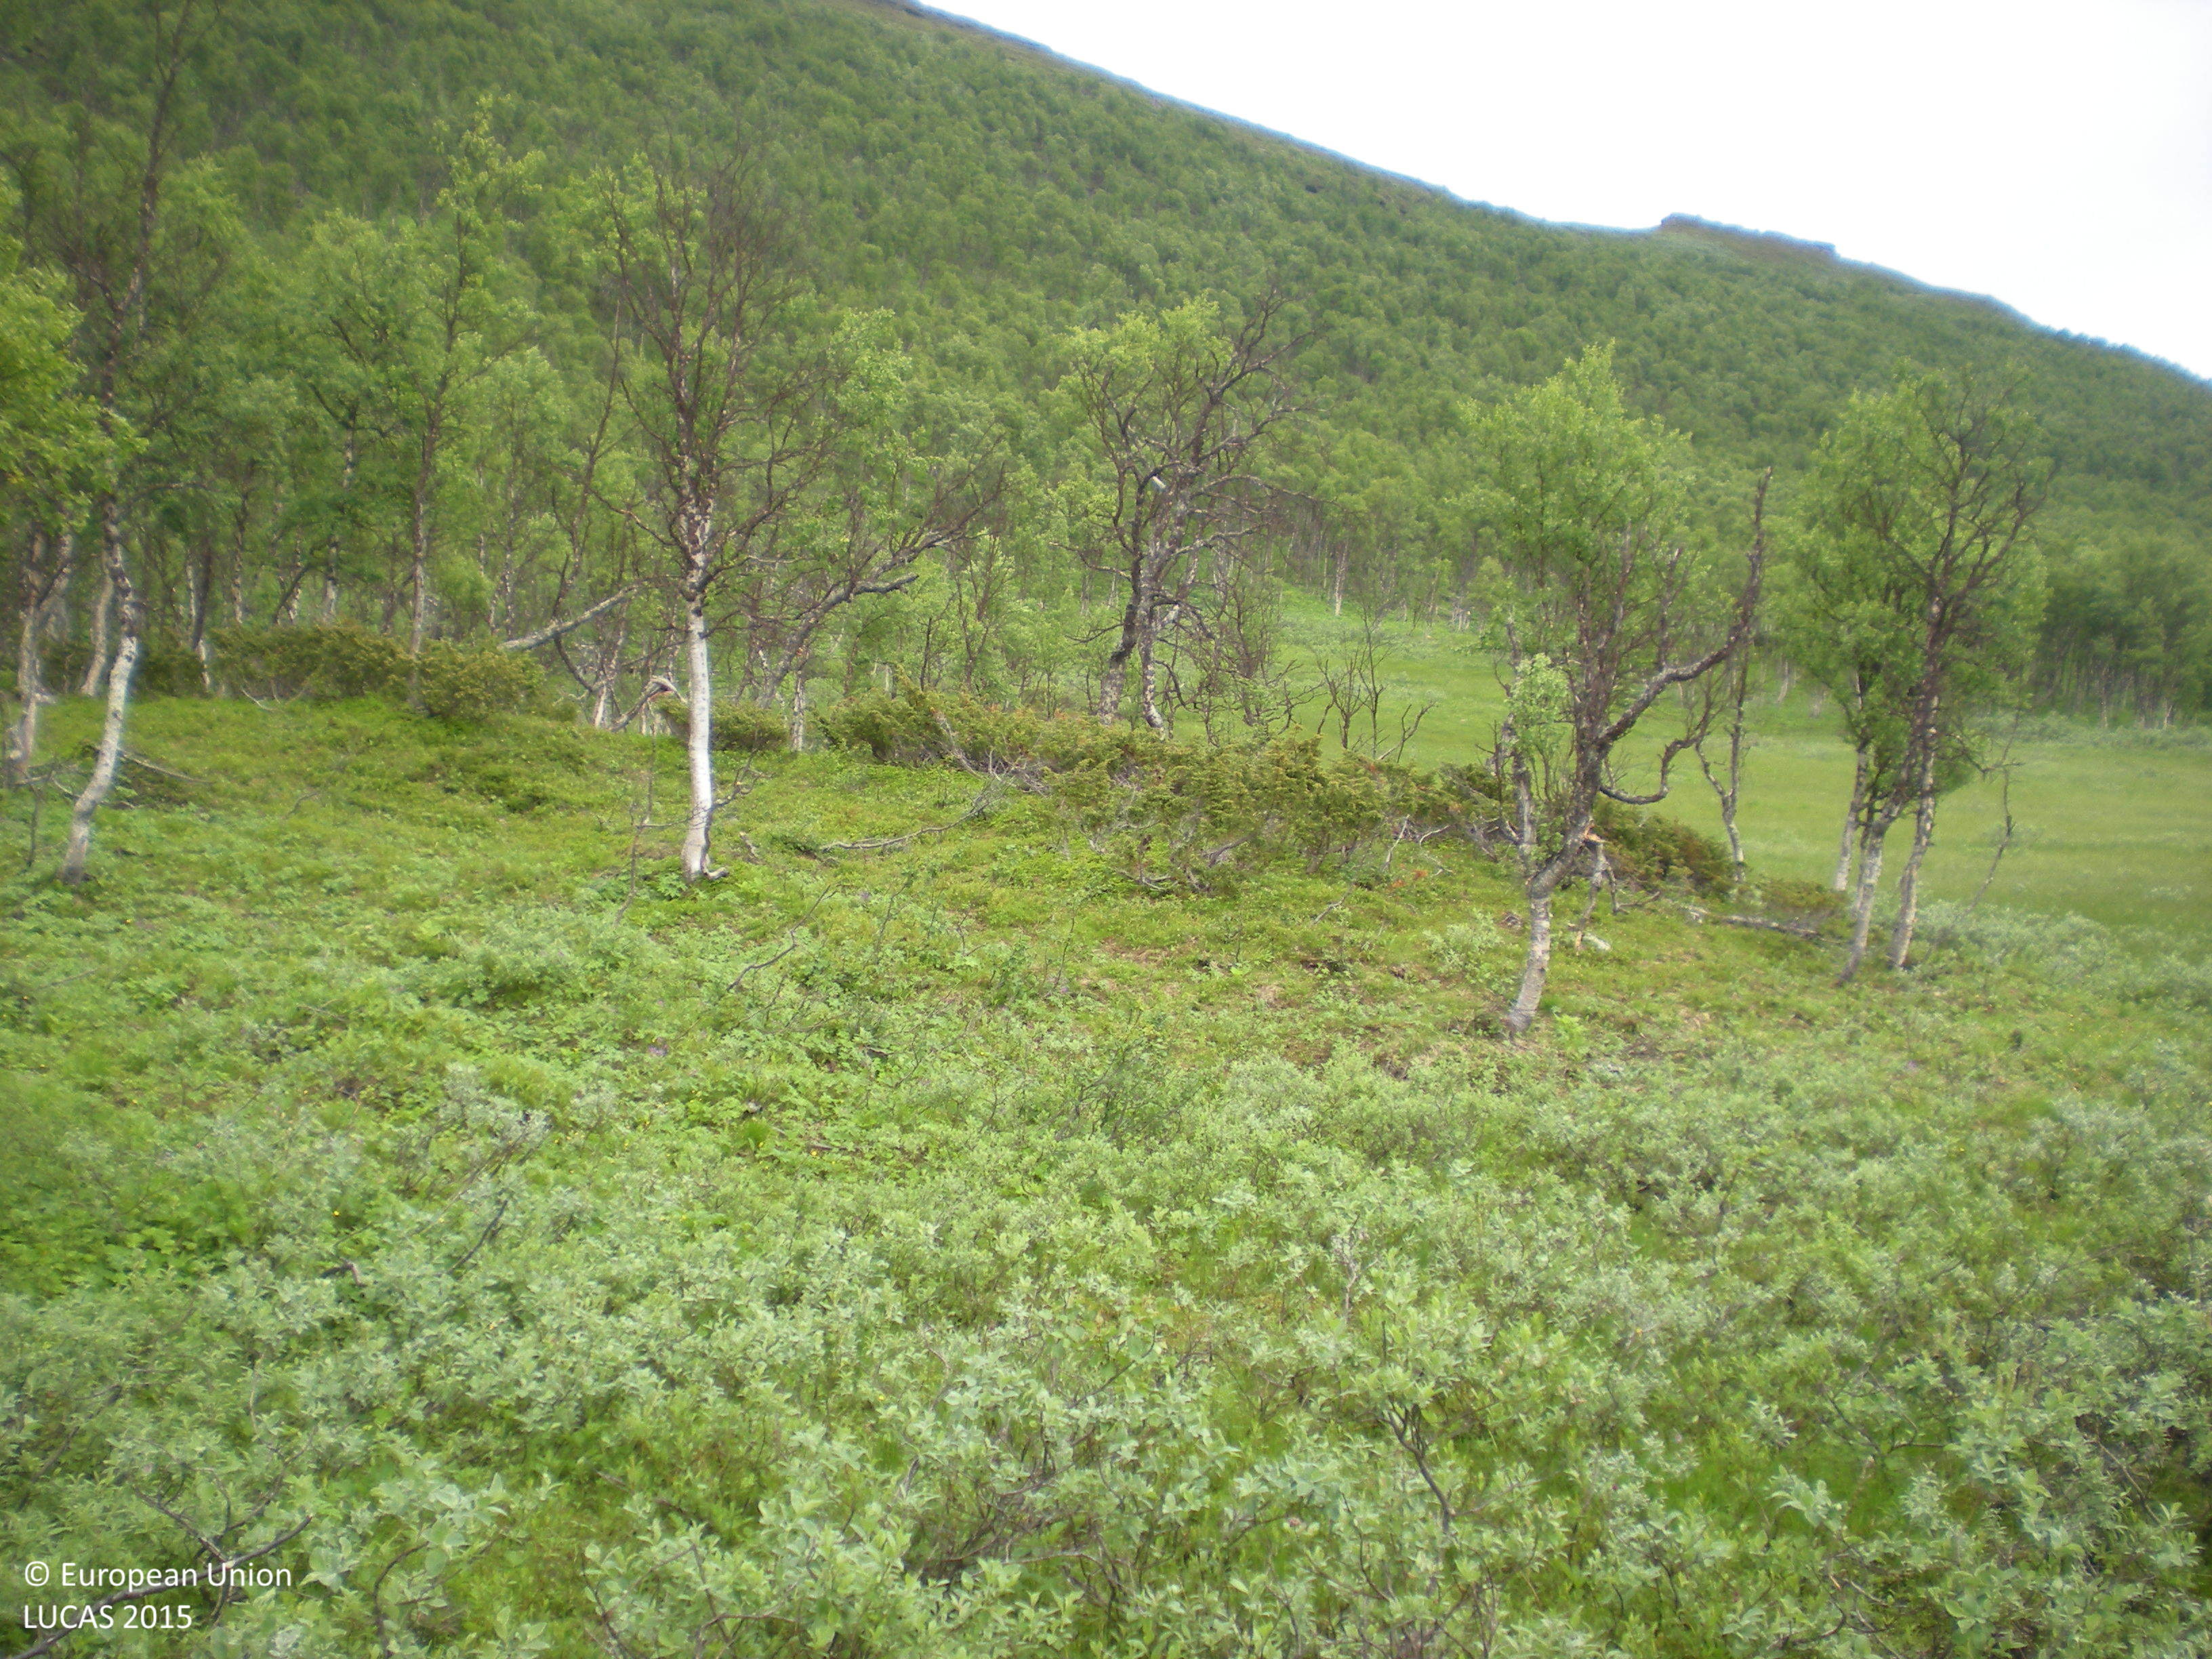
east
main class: Woodland
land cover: Broadleaved woodland
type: boreal forest
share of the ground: 25 - 50 %
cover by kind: broadleaved forest trees 50 %, herbaceous plants 30 %, shrubs 20 %
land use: Semi-natural and natural areas not in use
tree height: < 5 m
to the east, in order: Broadleaved woodland; Peatbogs; Broadleaved woodland
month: August
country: SE
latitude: 66.6933
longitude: 16.0928
